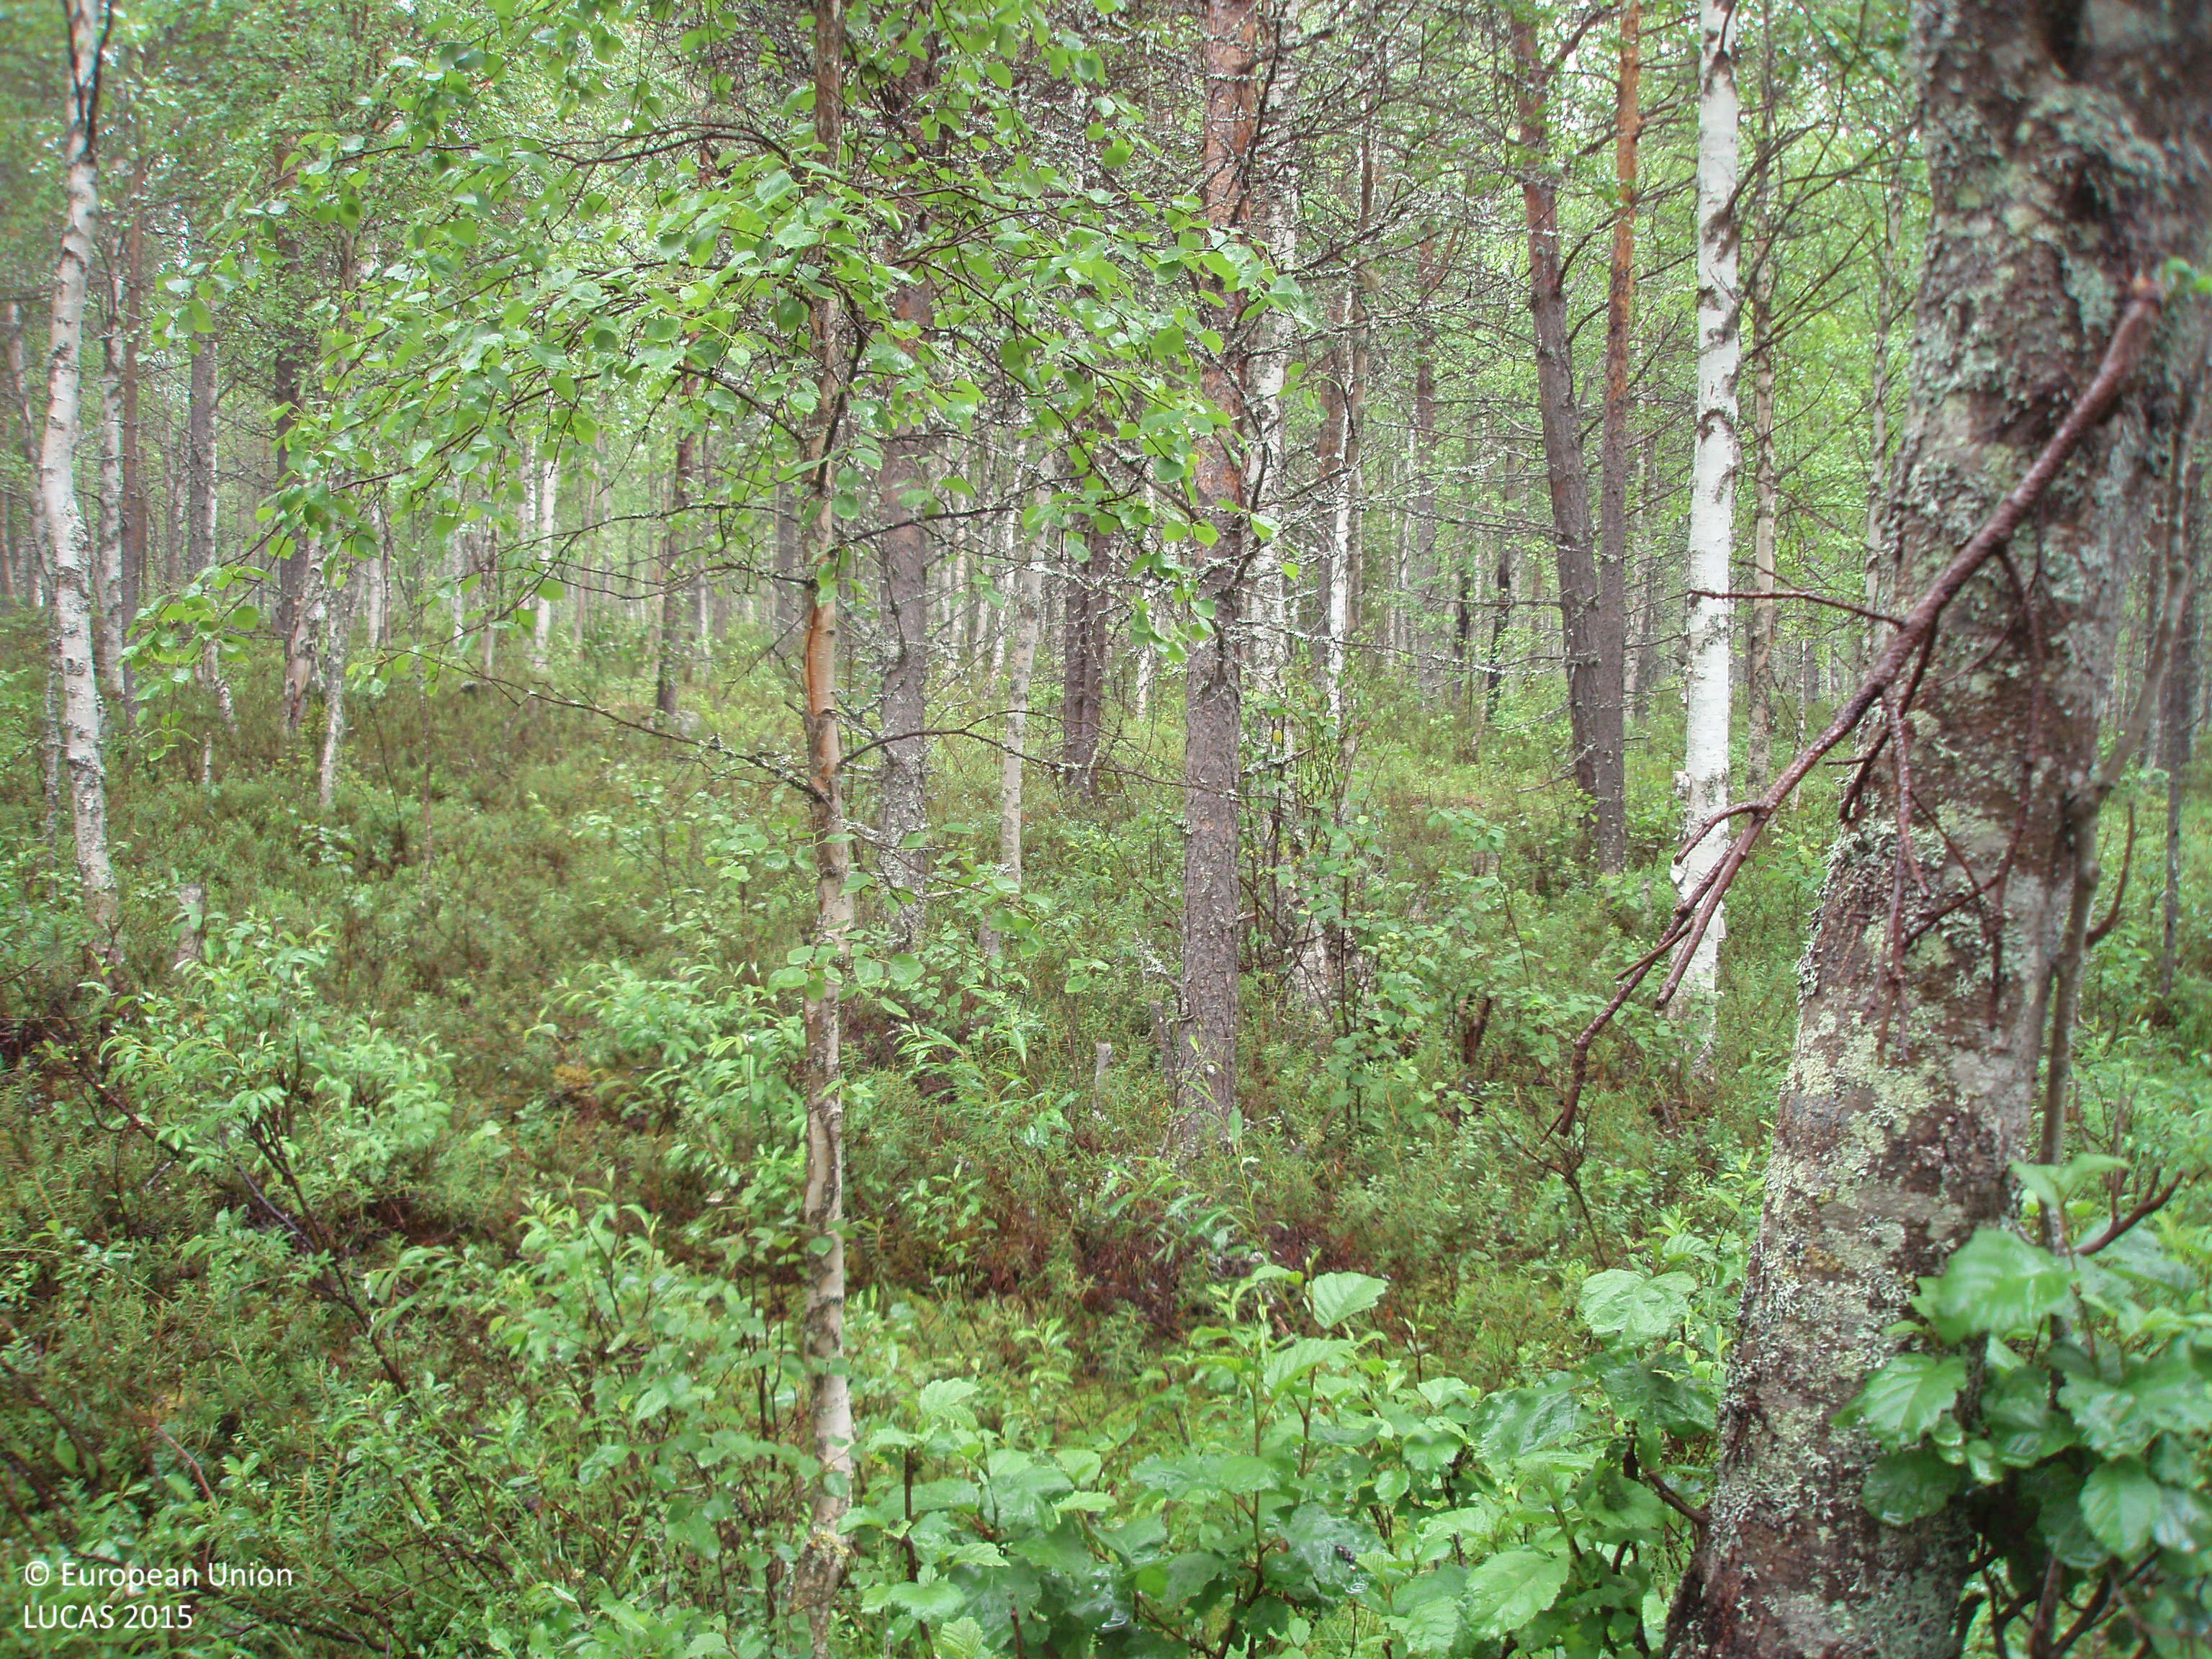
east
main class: Woodland
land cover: Pine dominated mixed woodland
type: boreal forest
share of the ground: > 75 %
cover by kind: broadleaved forest trees 55 %, coniferous forest trees 25 %, shrubs 20 %
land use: Forestry
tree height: > 5 m
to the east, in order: Pine dominated mixed woodland; Ditches and canals; Pine dominated mixed woodland; Ditches and canals; Pine dominated mixed woodland; Ditches and canals; Pine dominated mixed woodland; Ditches and canals; Pine dominated mixed woodland; Ditches and canals; Pine dominated coniferous woodland; Ditches and canals; Pine dominated mixed woodland
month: July
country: FI
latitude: 66.7239
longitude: 27.9255
